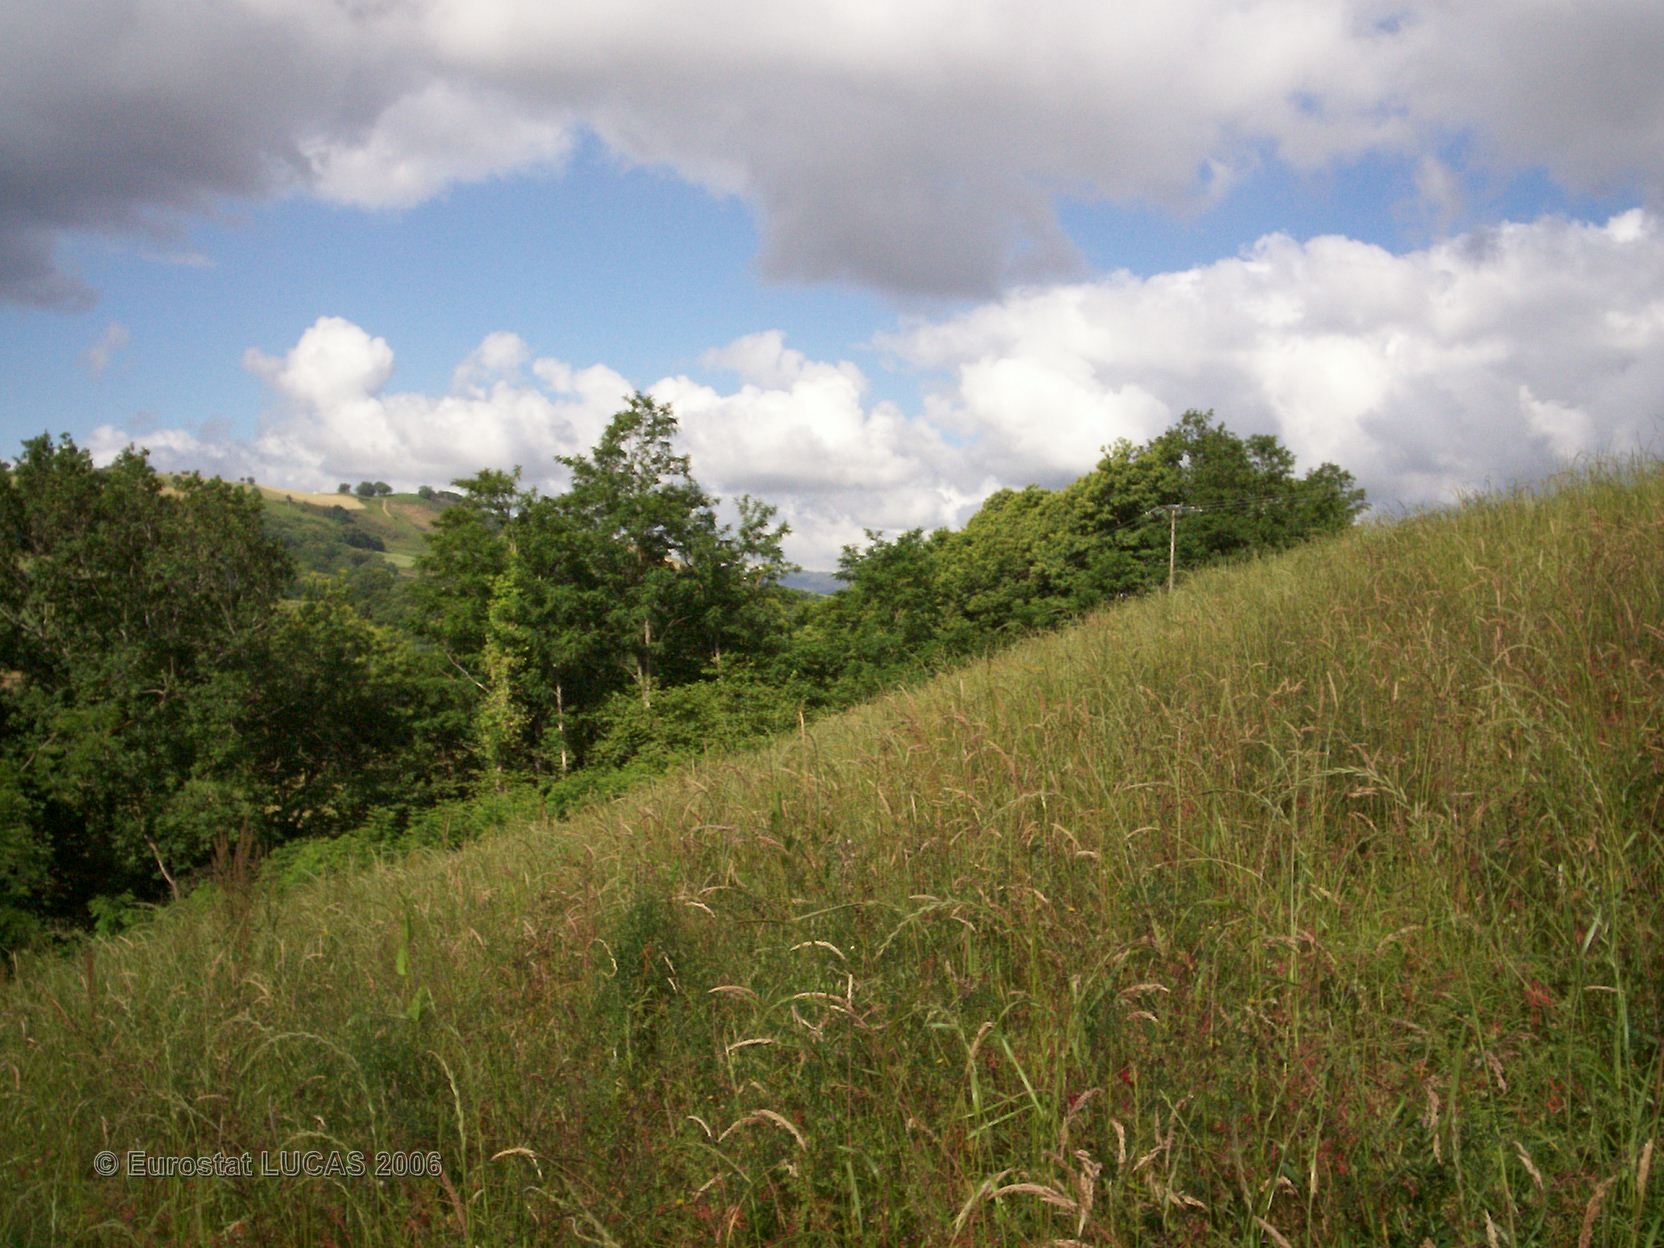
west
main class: Grassland
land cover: Grassland without tree/shrub cover
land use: Agriculture (excluding fallow land and kitchen gardens)
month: May
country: FR
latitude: 43.3335
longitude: -1.2757
